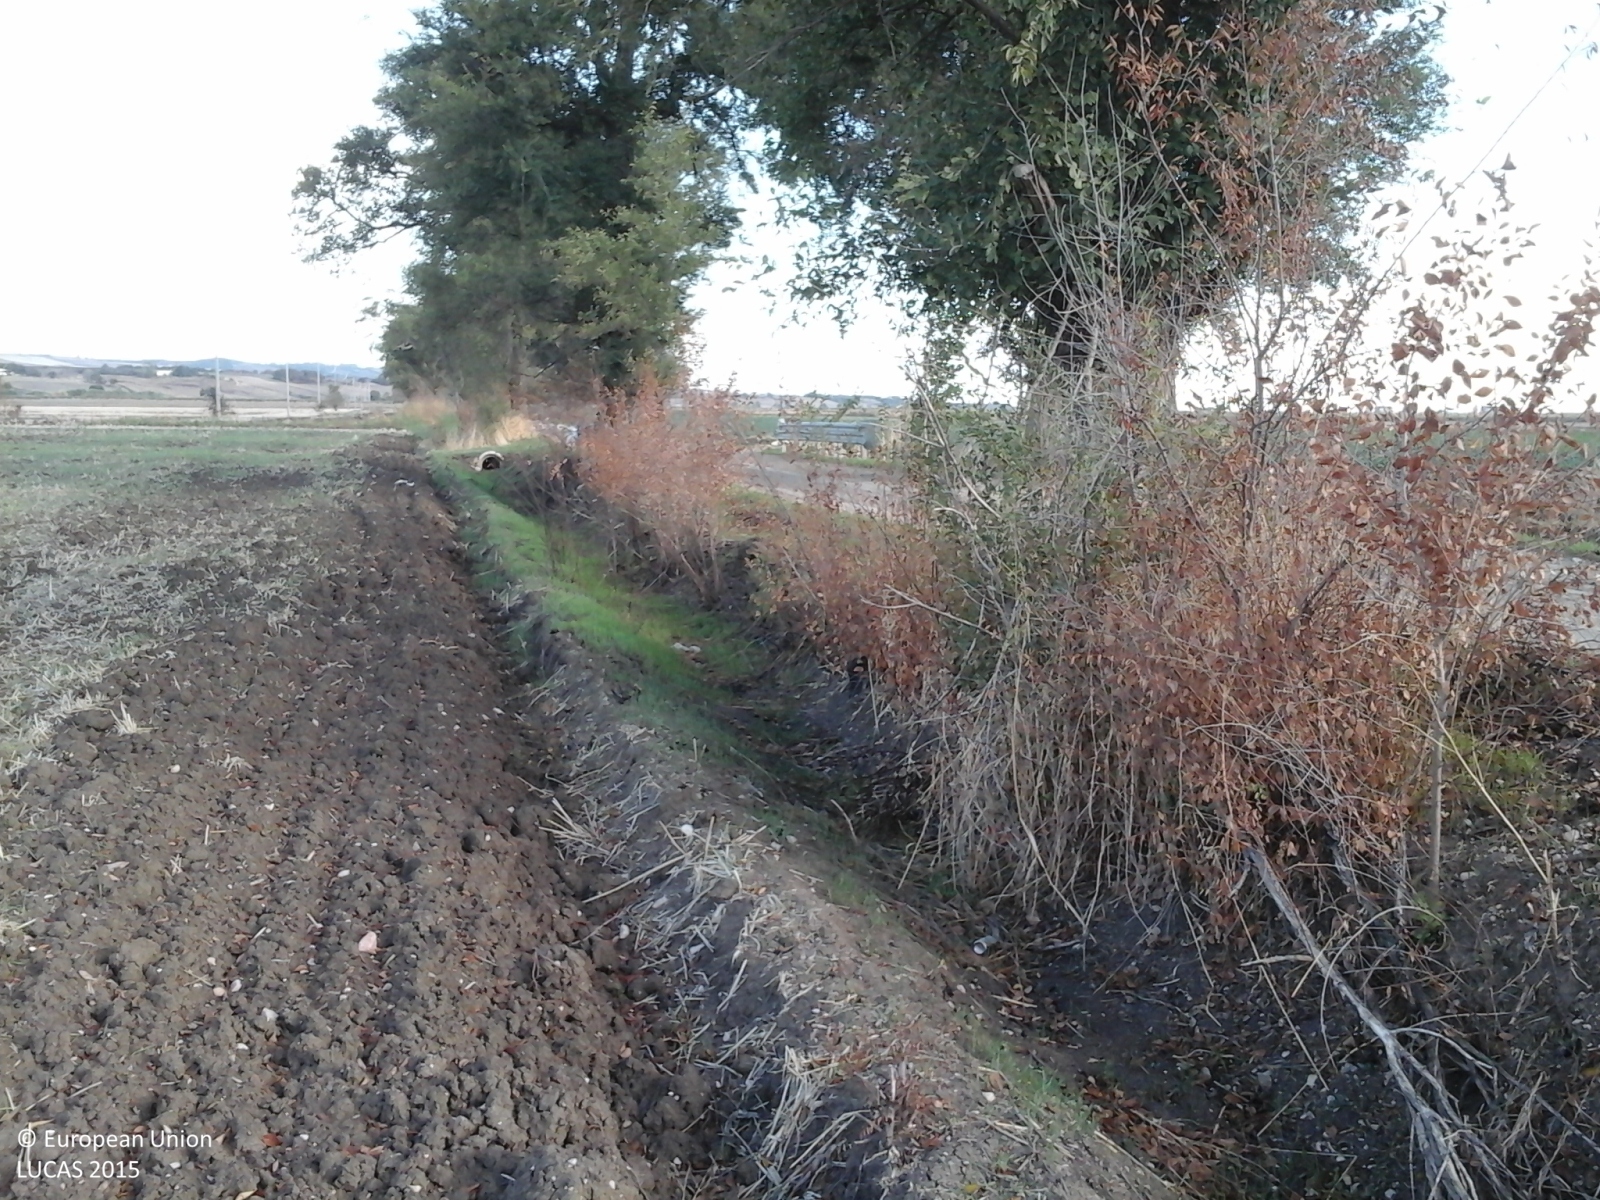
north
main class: Cropland
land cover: Durum wheat
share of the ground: > 75 %
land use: Agriculture (excluding fallow land and kitchen gardens)
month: October
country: IT
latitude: 41.7955
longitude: 15.2187
